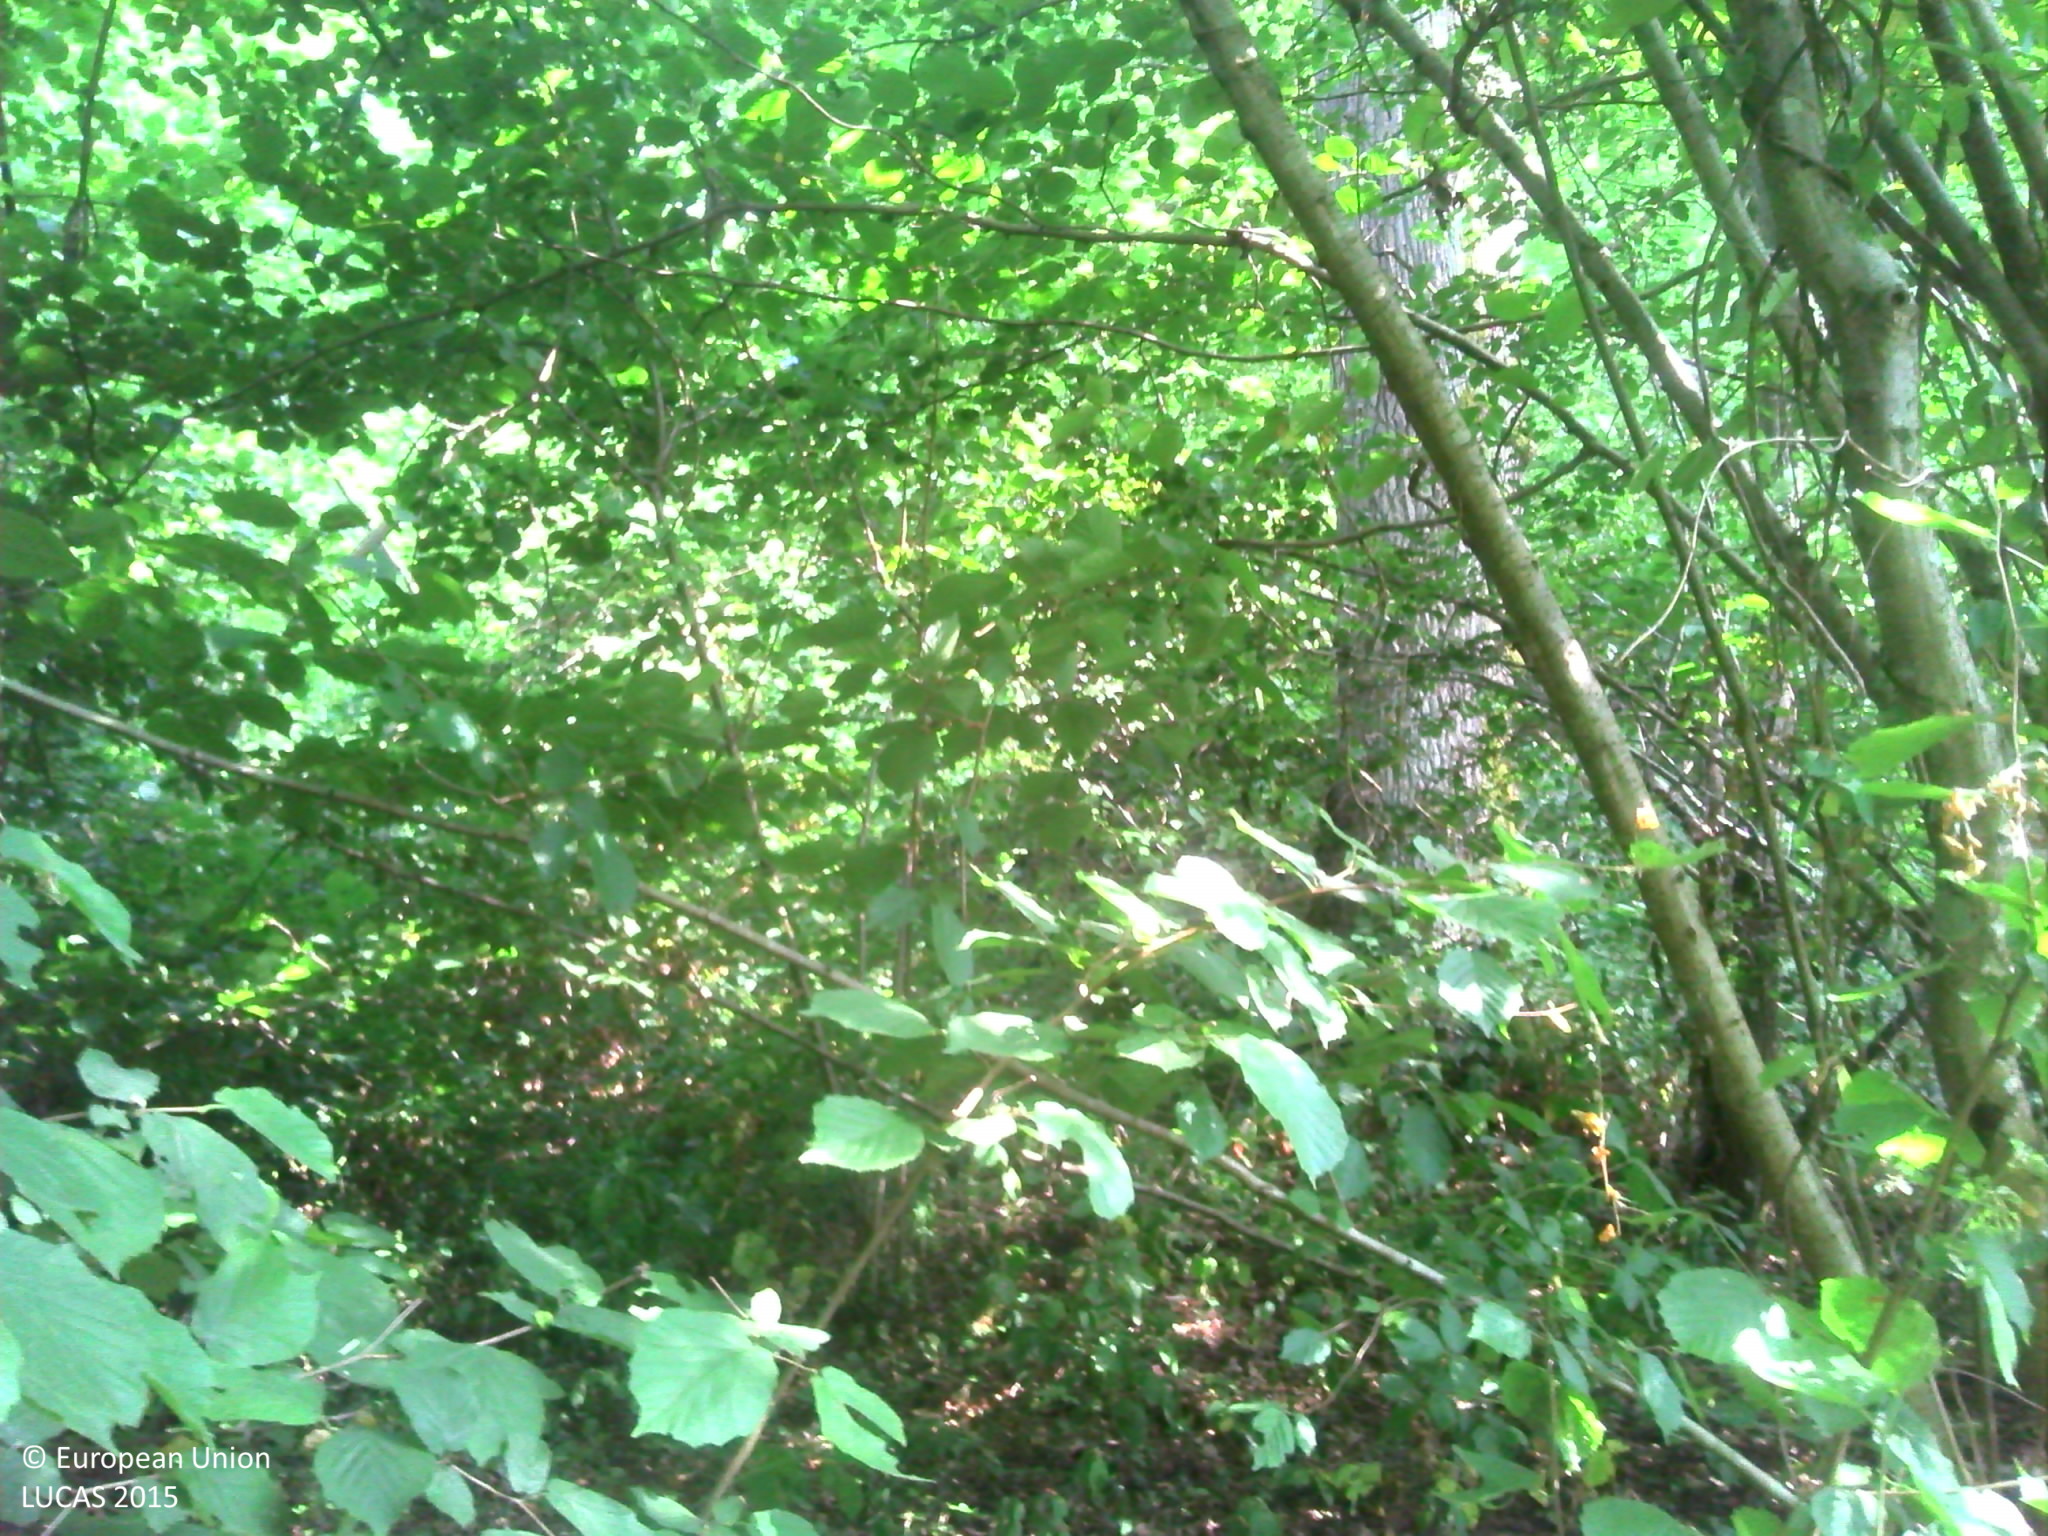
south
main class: Woodland
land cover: Broadleaved woodland
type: mesophytic deciduous forest
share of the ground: > 75 %
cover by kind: broadleaved forest trees 85 %, herbaceous plants 10 %, shrubs 5 %
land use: Forestry
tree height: > 5 m
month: July
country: FR
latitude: 46.8348
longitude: 5.1112
